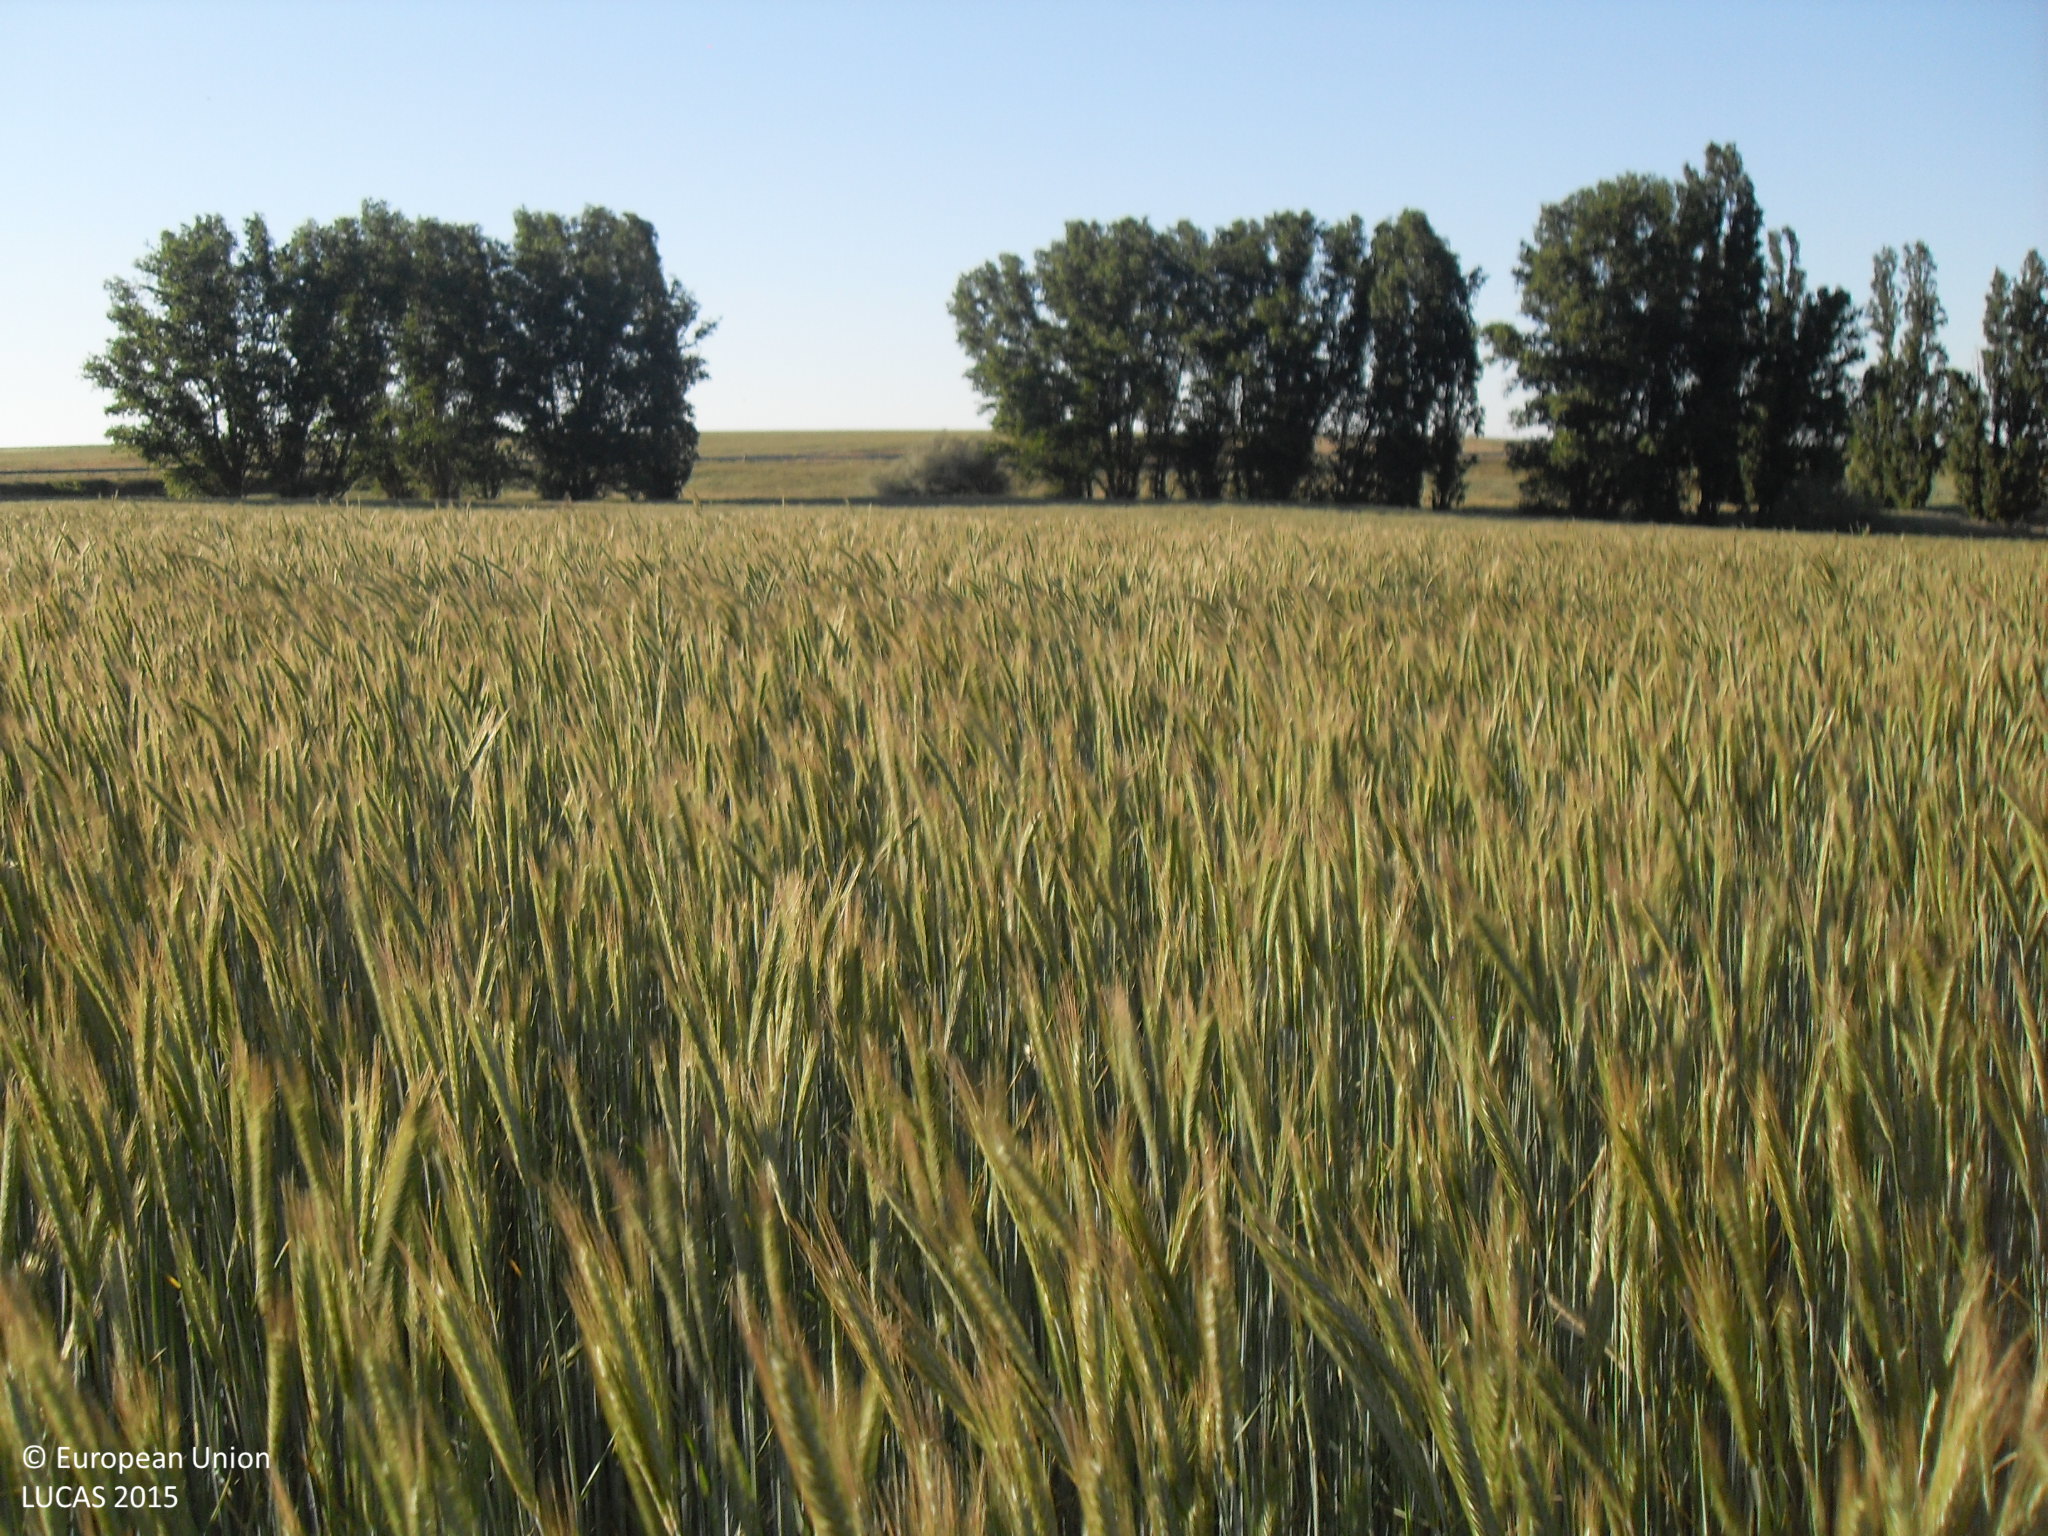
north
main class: Cropland
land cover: Rye
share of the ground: > 75 %
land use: Agriculture (excluding fallow land and kitchen gardens)
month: May
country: ES
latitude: 41.0239
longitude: -5.3059
